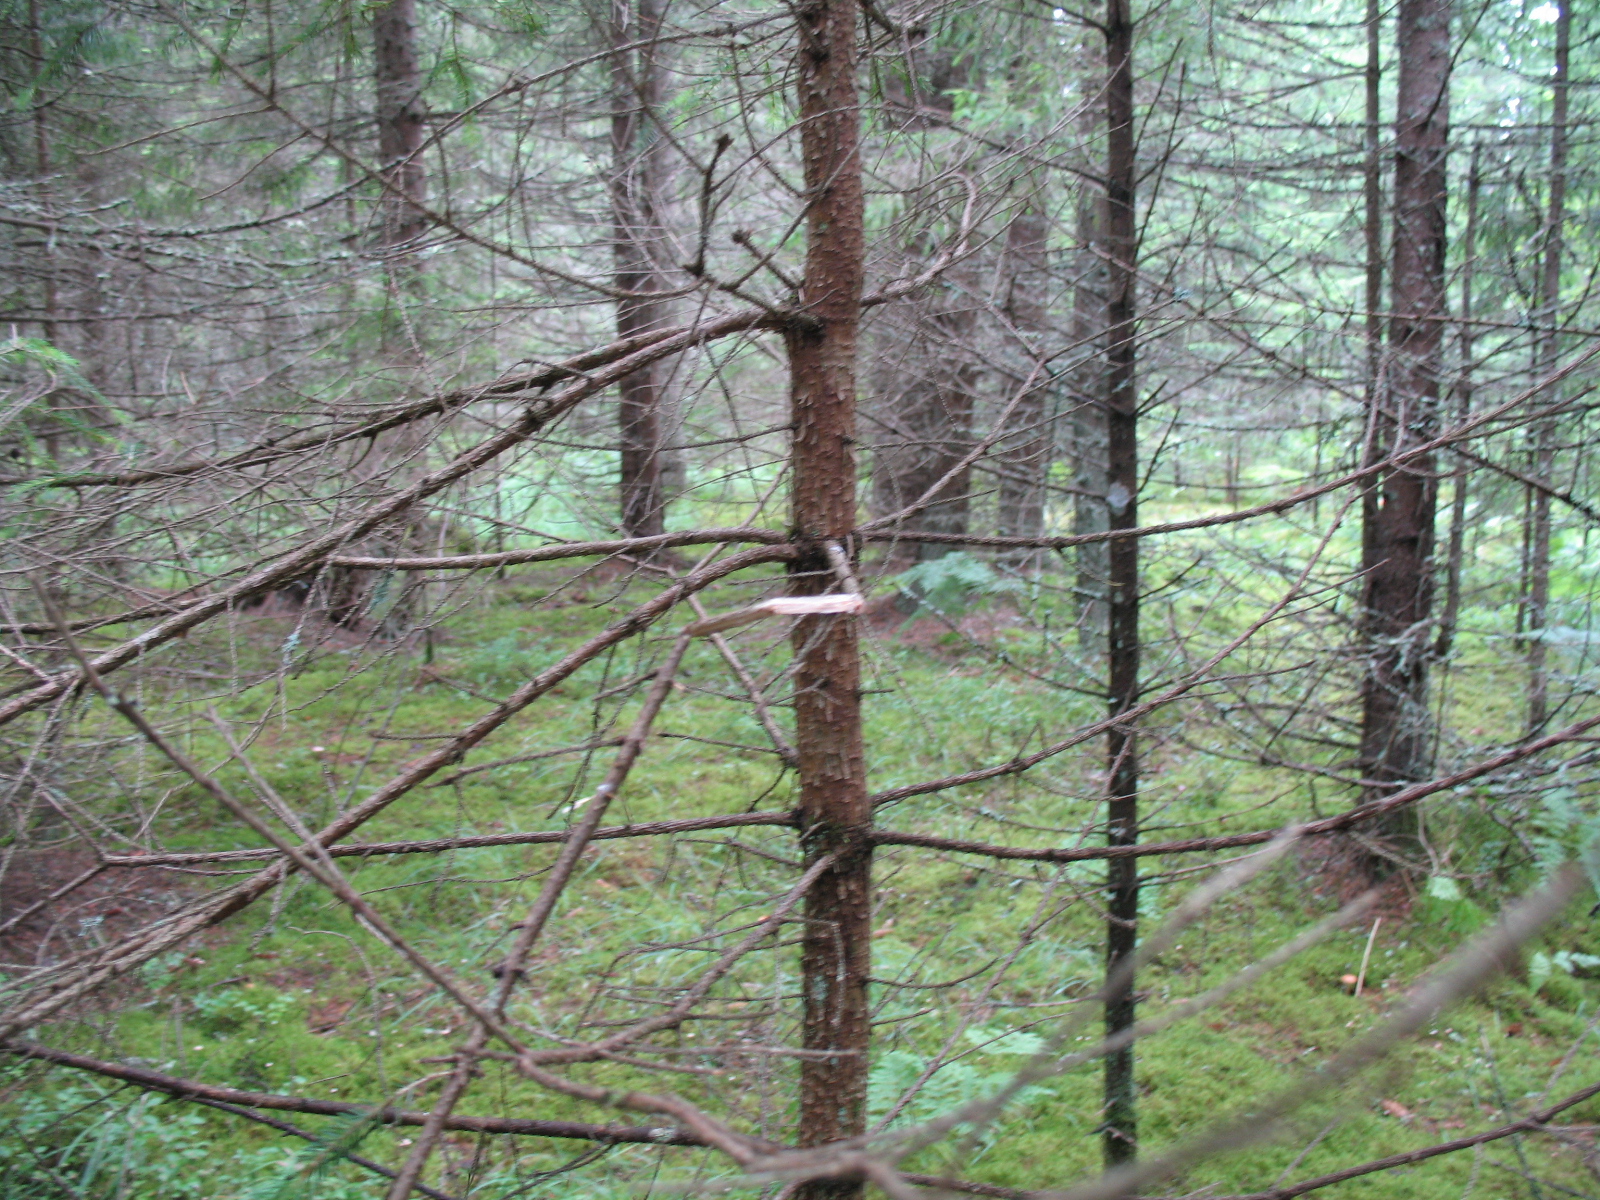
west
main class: Woodland
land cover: Spruce dominated coniferous woodland
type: hemiboreal forest and nemoral coniferous forest and mixed broadleaved-coniferous forest
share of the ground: > 75 %
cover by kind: coniferous forest trees 80 %, lichens and mosses 15 %, herbaceous plants 5 %
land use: Forestry
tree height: > 5 m
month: July
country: LV
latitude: 56.3937
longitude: 25.1951
